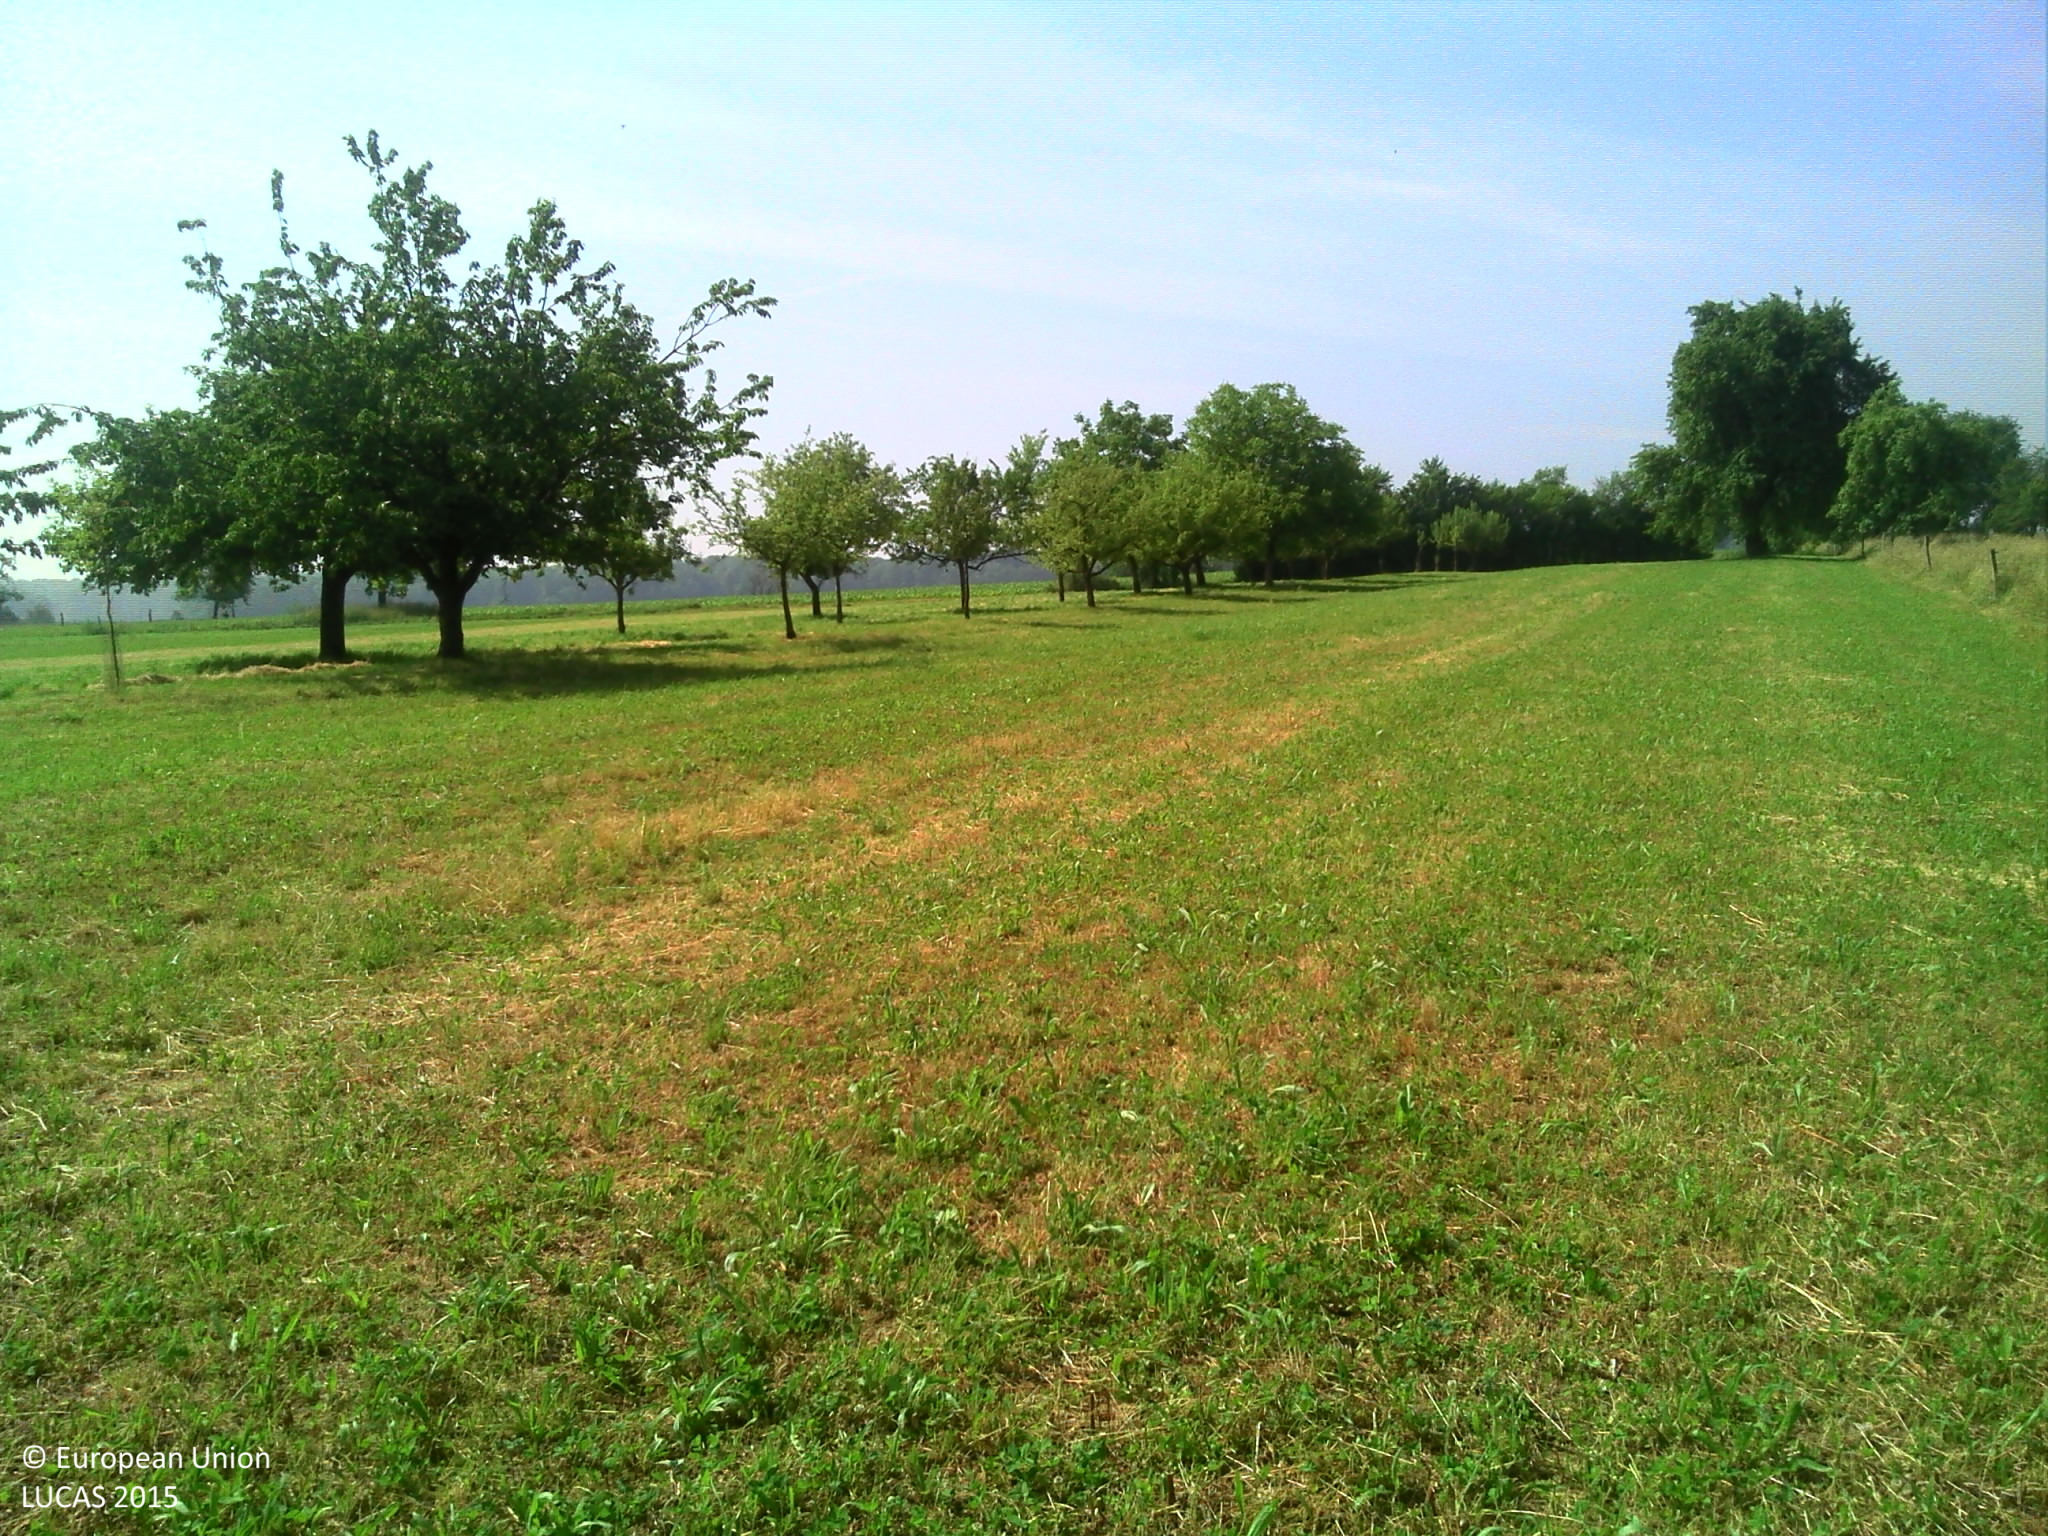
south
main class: Cropland
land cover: Apple fruit
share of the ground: 25 - 50 %
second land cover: Grassland without tree/shrub cover
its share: > 75 %
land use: Agriculture (excluding fallow land and kitchen gardens)
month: June
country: FR
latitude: 47.5443
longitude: 7.3842
